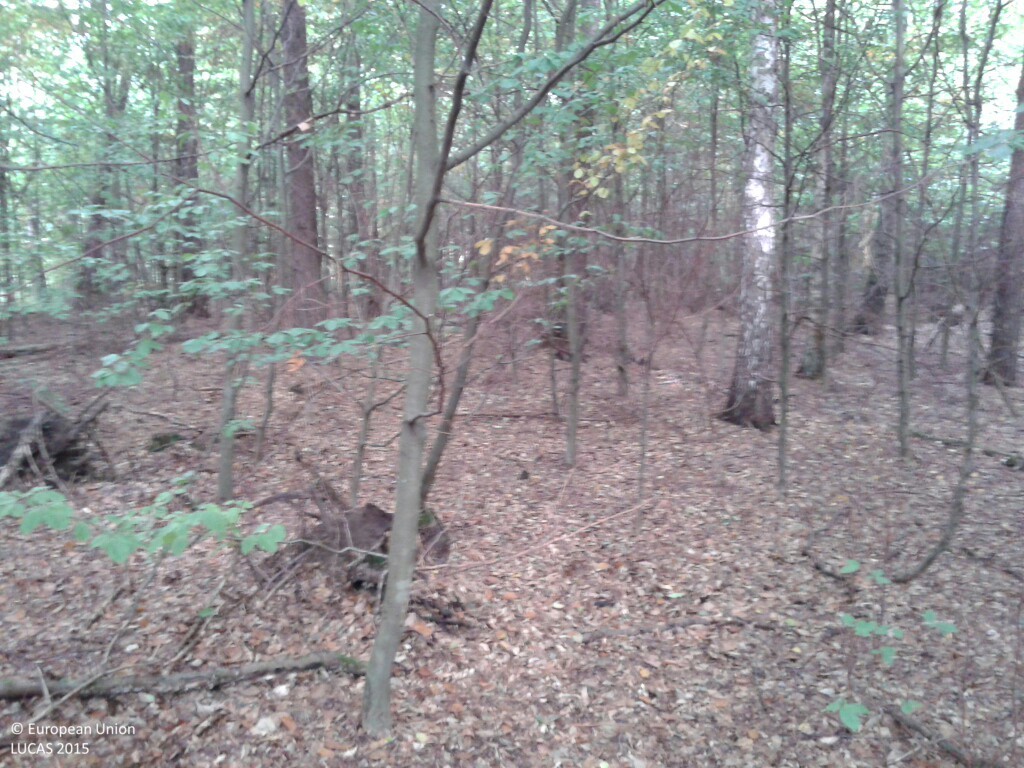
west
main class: Woodland
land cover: Other mixed woodland
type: acidophilous oak and oak-birch forest
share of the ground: > 75 %
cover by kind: broadleaved forest trees 60 %, coniferous forest trees 30 %, unconsolidated bare surface 10 %
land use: Forestry
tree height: > 5 m
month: September
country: PL
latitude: 53.6955
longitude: 20.1960
